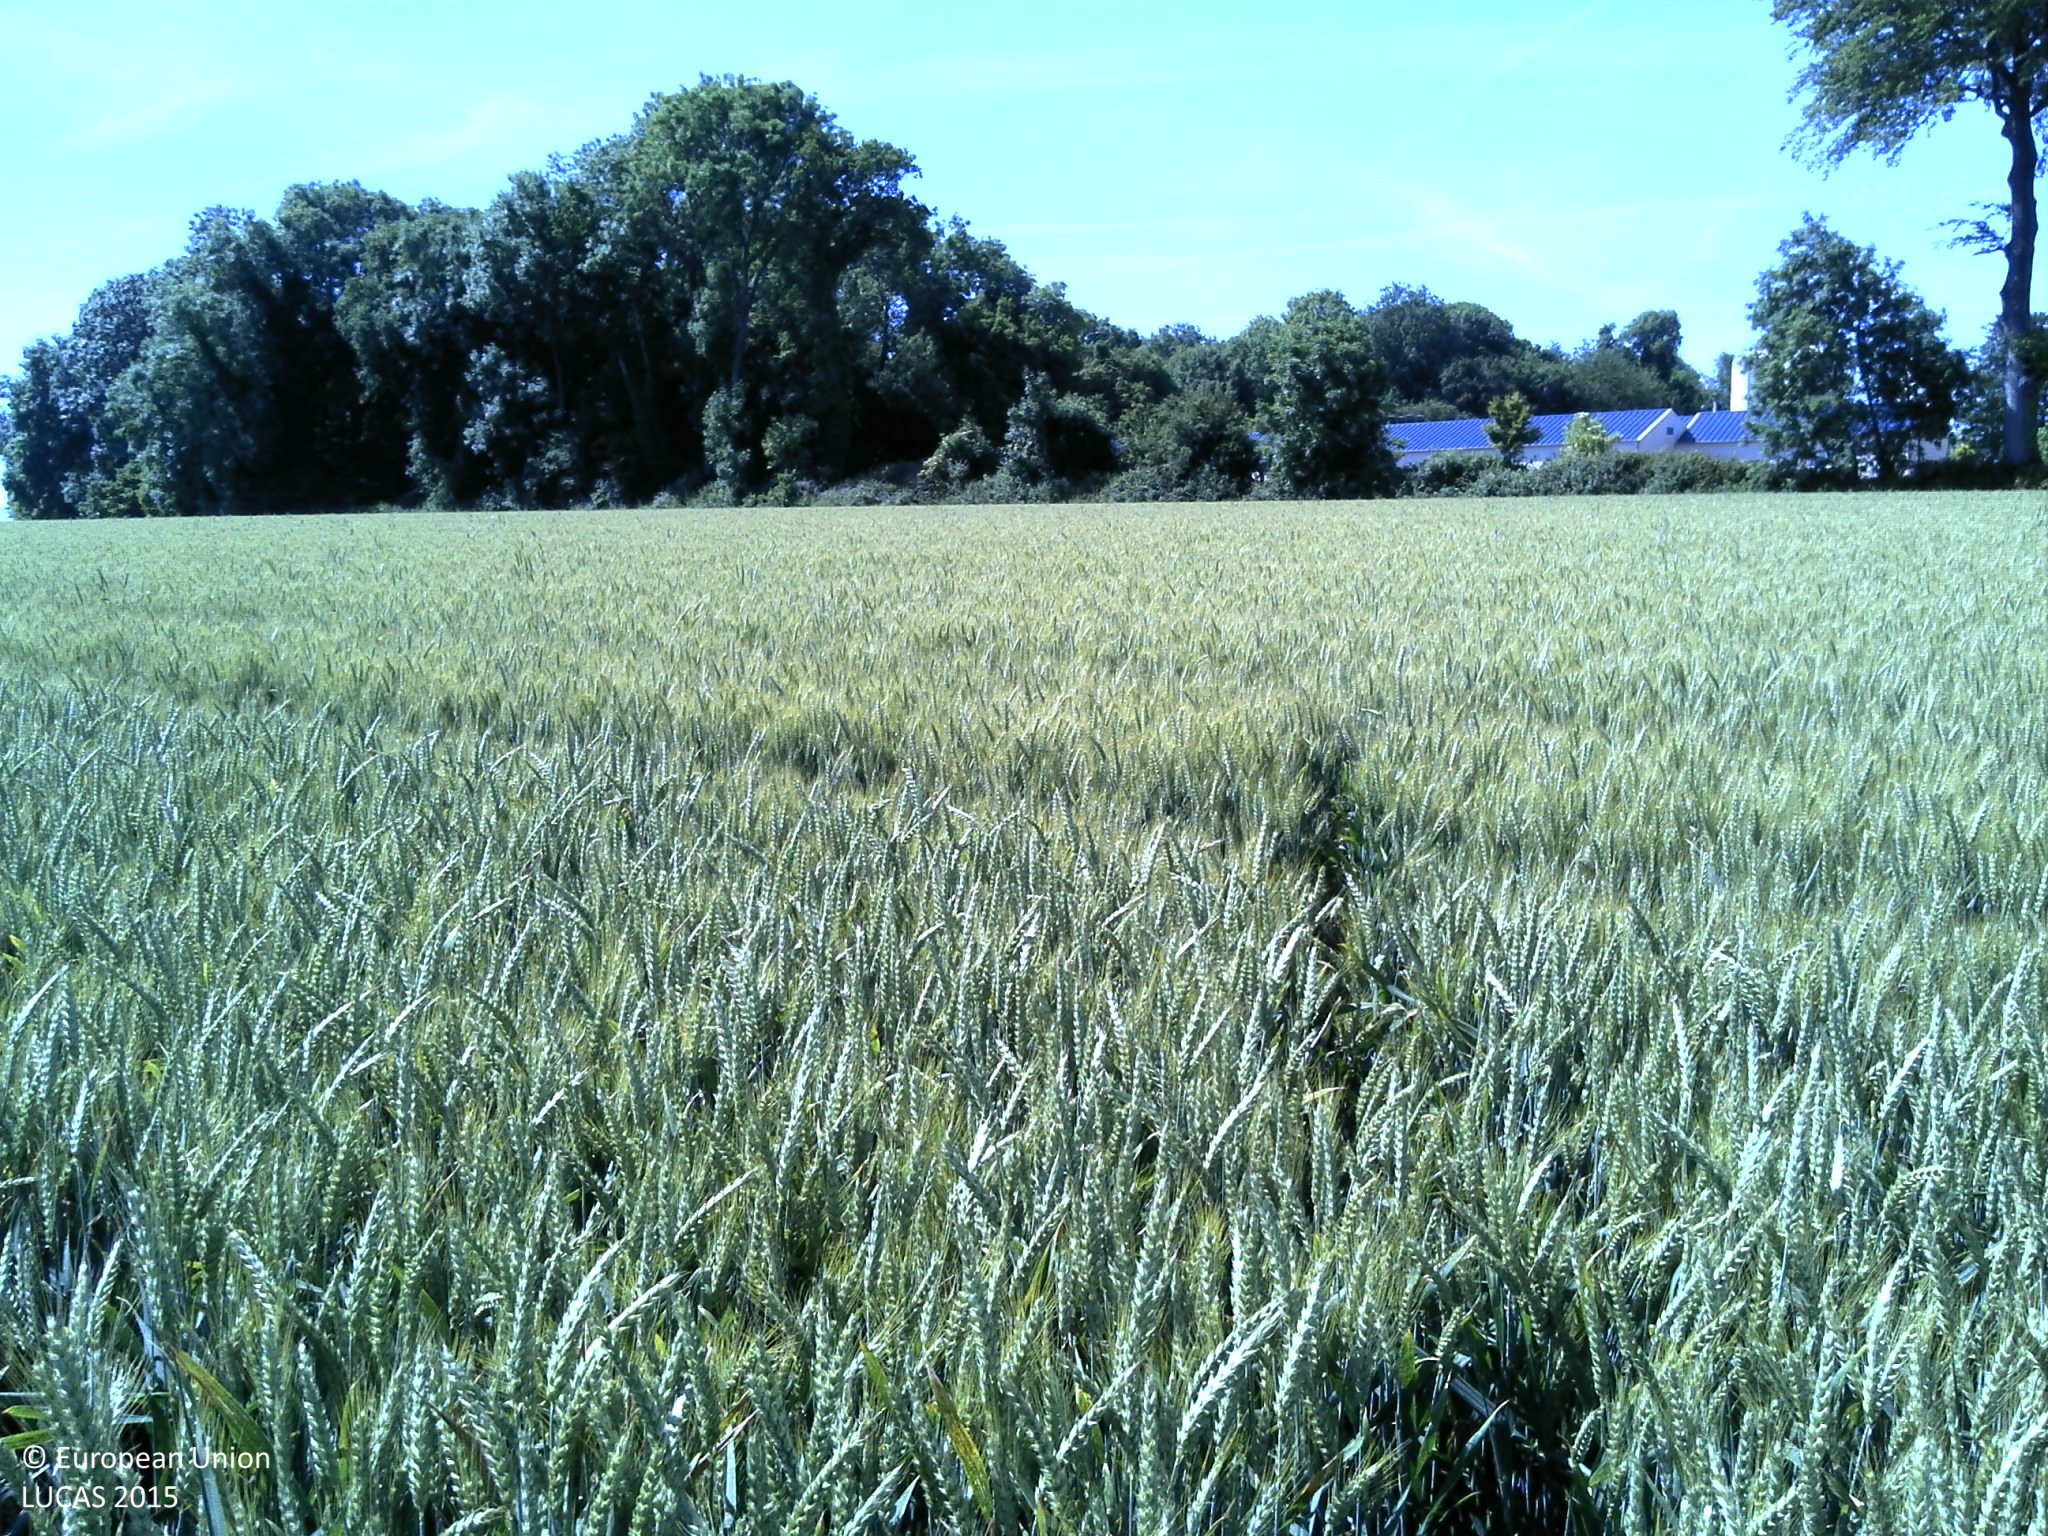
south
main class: Cropland
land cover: Common wheat
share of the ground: > 75 %
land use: Agriculture (excluding fallow land and kitchen gardens)
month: June
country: FR
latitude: 49.7707
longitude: 0.9658
